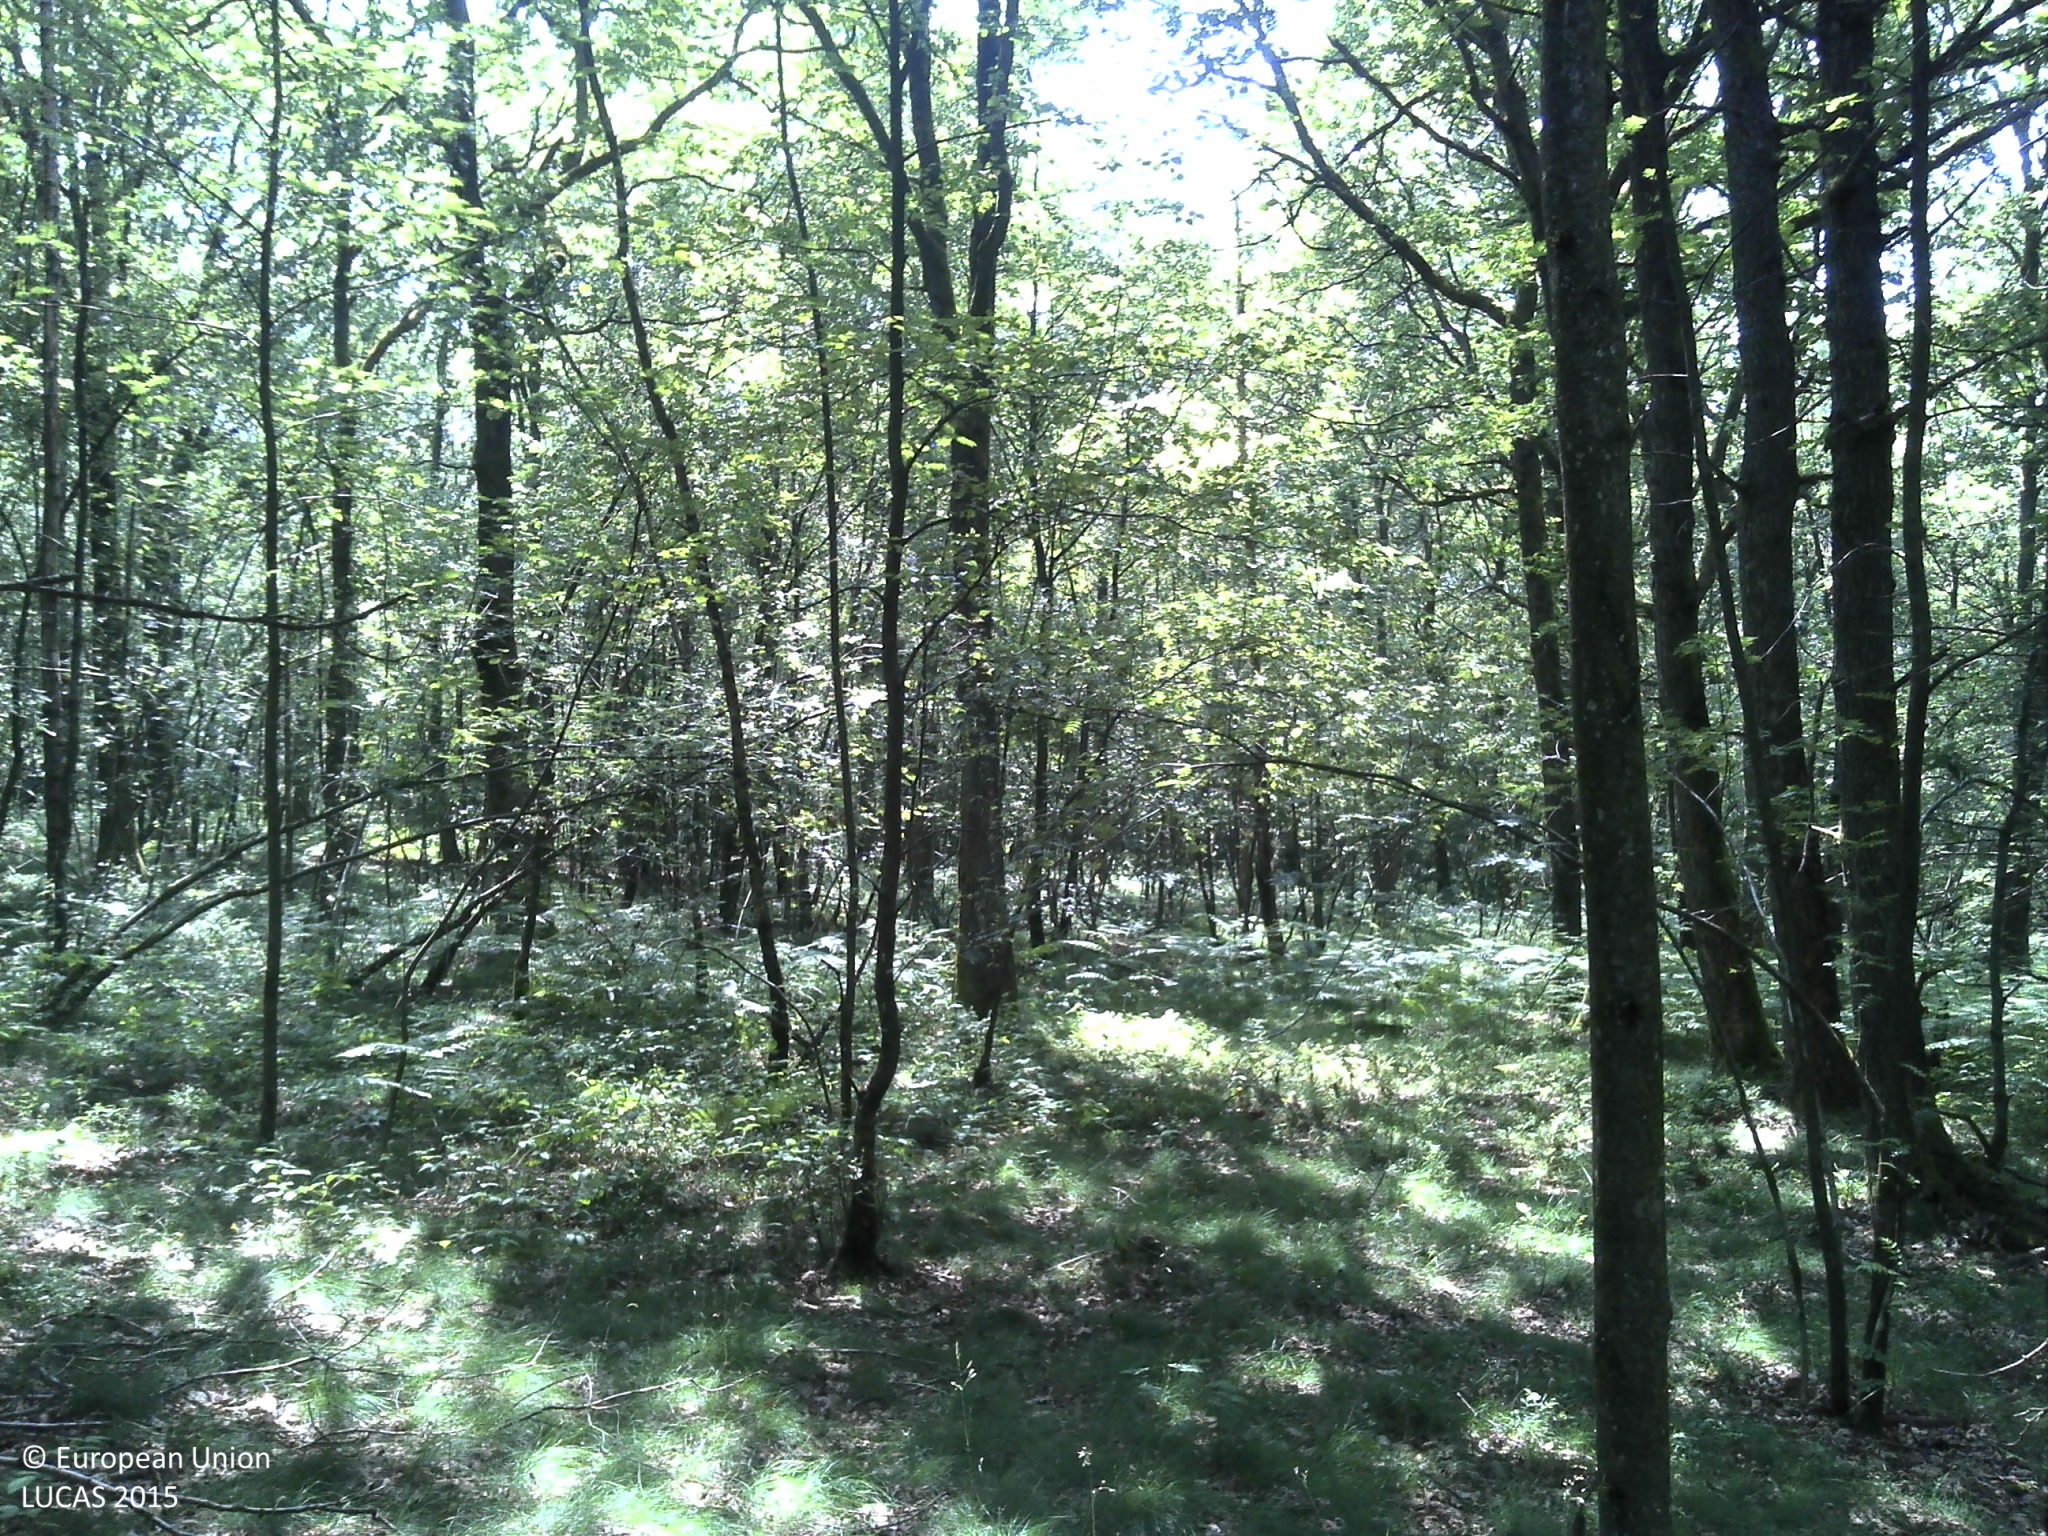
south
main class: Woodland
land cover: Broadleaved woodland
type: acidophilous oak and oak-birch forest
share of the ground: 50 - 75 %
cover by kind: broadleaved forest trees 70 %, herbaceous plants 25 %, consolidated bare surface 5 %
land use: Forestry
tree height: > 5 m
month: July
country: FR
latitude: 49.9203
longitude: 4.7738
